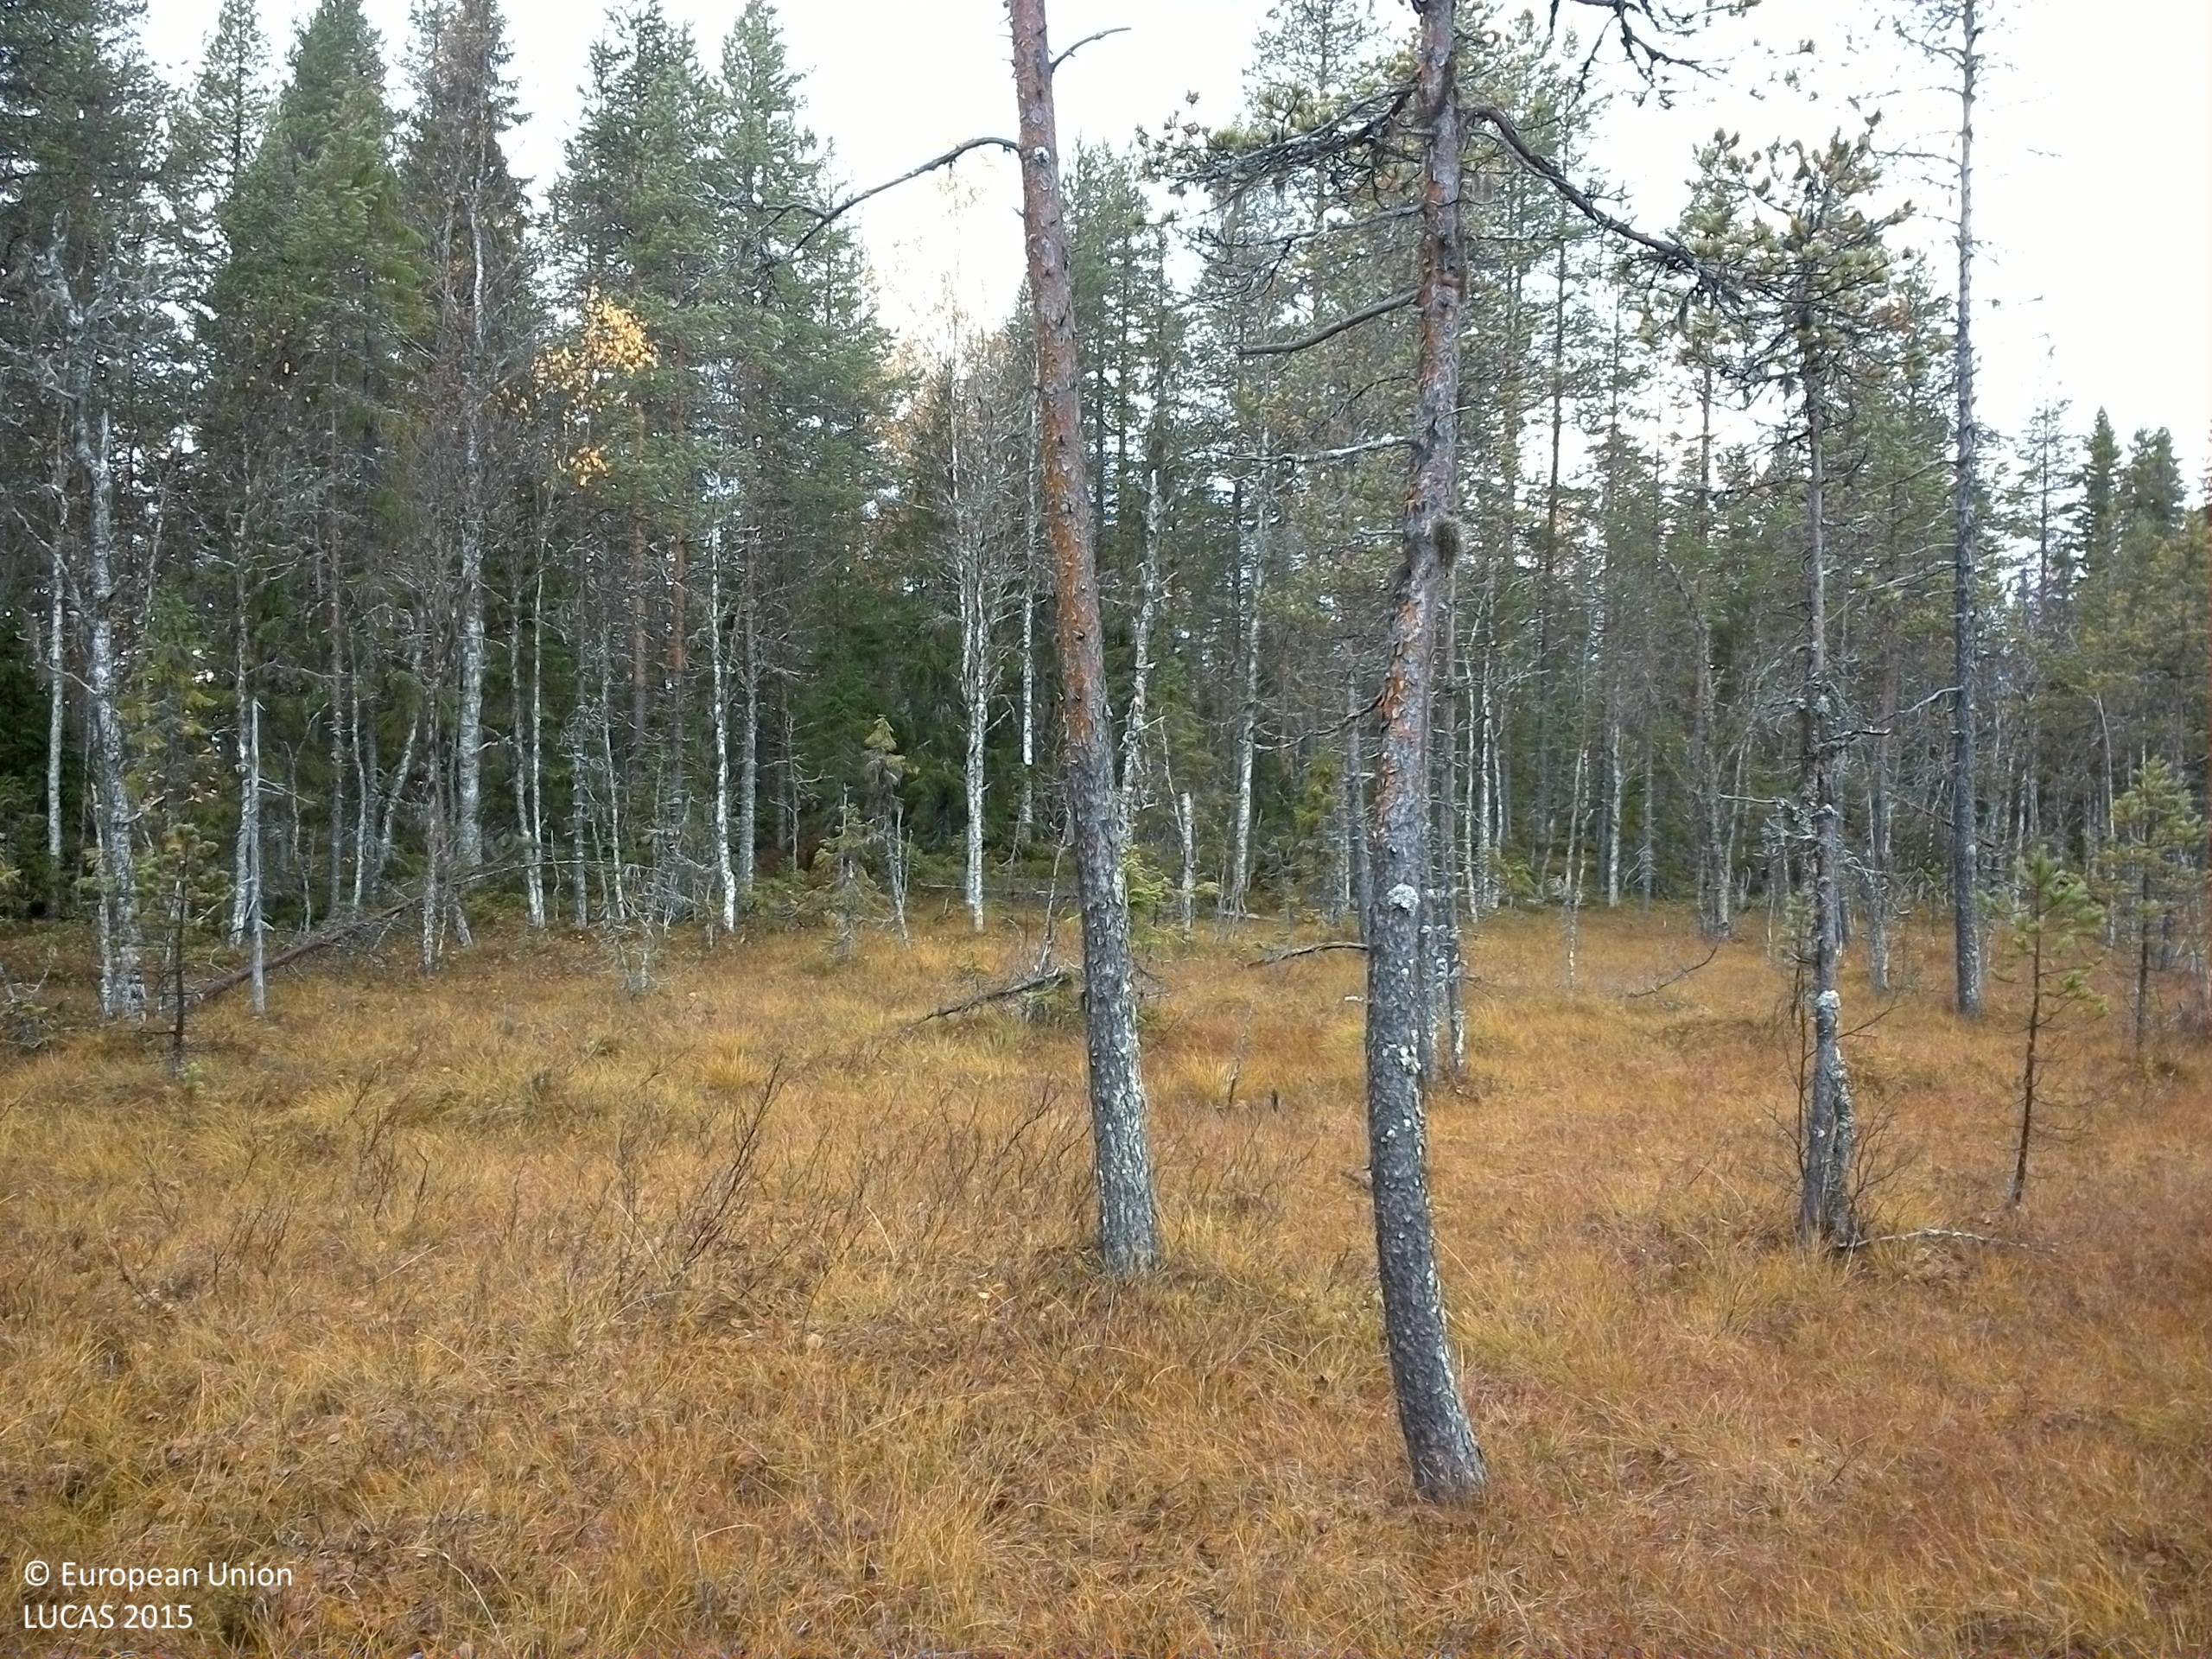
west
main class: Woodland
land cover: Pine dominated mixed woodland
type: mire and swamp forests
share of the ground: 10 - 25 %
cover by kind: herbaceous plants 35 %, lichens and mosses 35 %, coniferous forest trees 15 %, shrubs 10 %, broadleaved forest trees 5 %
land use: Semi-natural and natural areas not in use
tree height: > 5 m
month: October
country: SE
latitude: 64.0503
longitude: 15.9728
